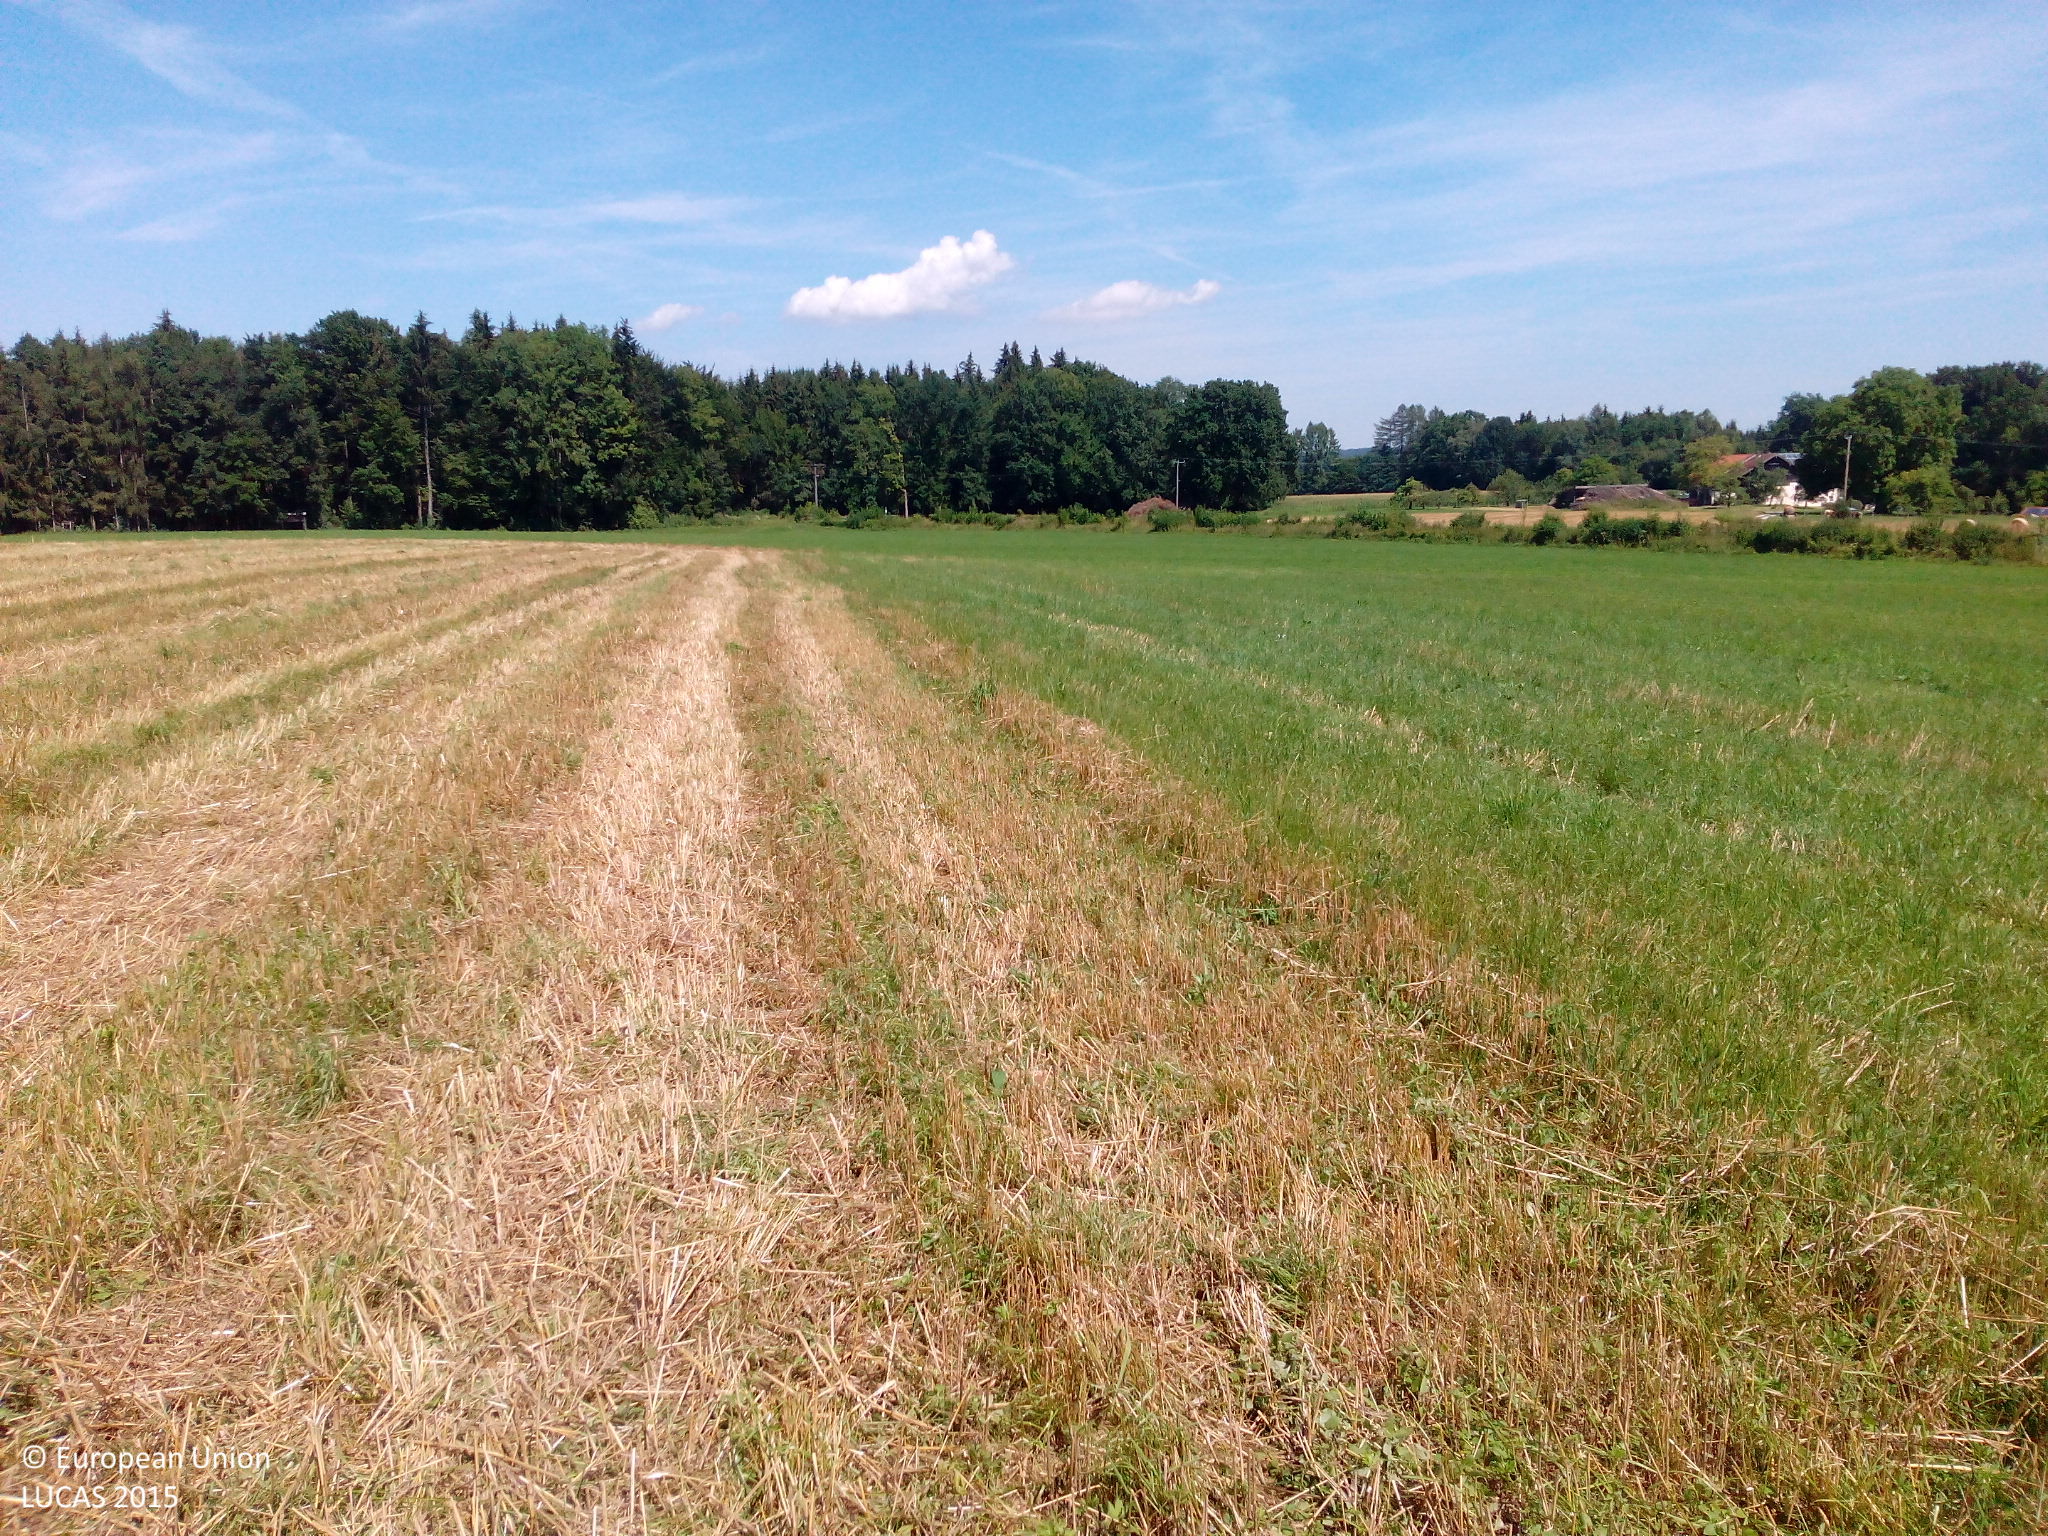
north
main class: Cropland
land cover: Common wheat
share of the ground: > 75 %
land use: Agriculture (excluding fallow land and kitchen gardens)
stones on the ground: < 10 %
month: August
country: DE
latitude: 47.9519
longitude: 12.8776
